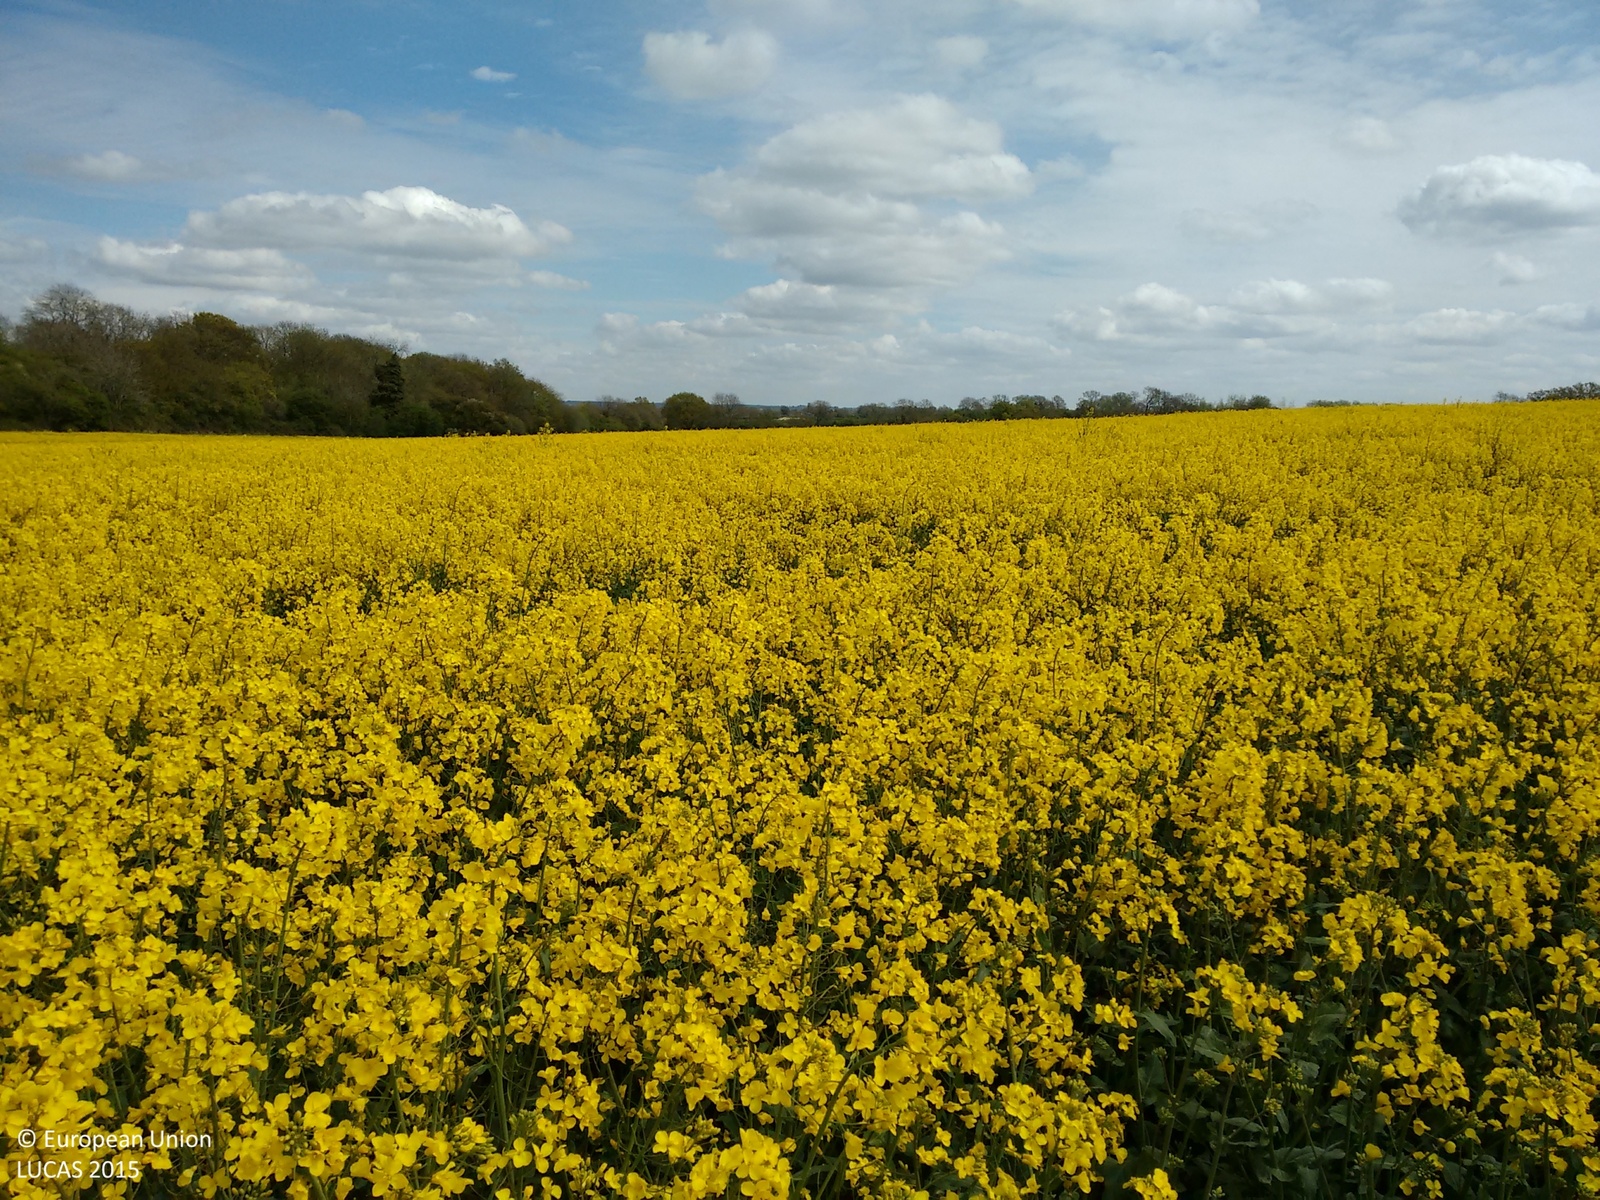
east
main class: Cropland
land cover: Rape and turnip rape
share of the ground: > 75 %
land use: Agriculture (excluding fallow land and kitchen gardens)
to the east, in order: Rape and turnip rape; Spontaneously vegetated surfaces
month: May
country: GB
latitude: 51.9739
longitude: -0.7998
